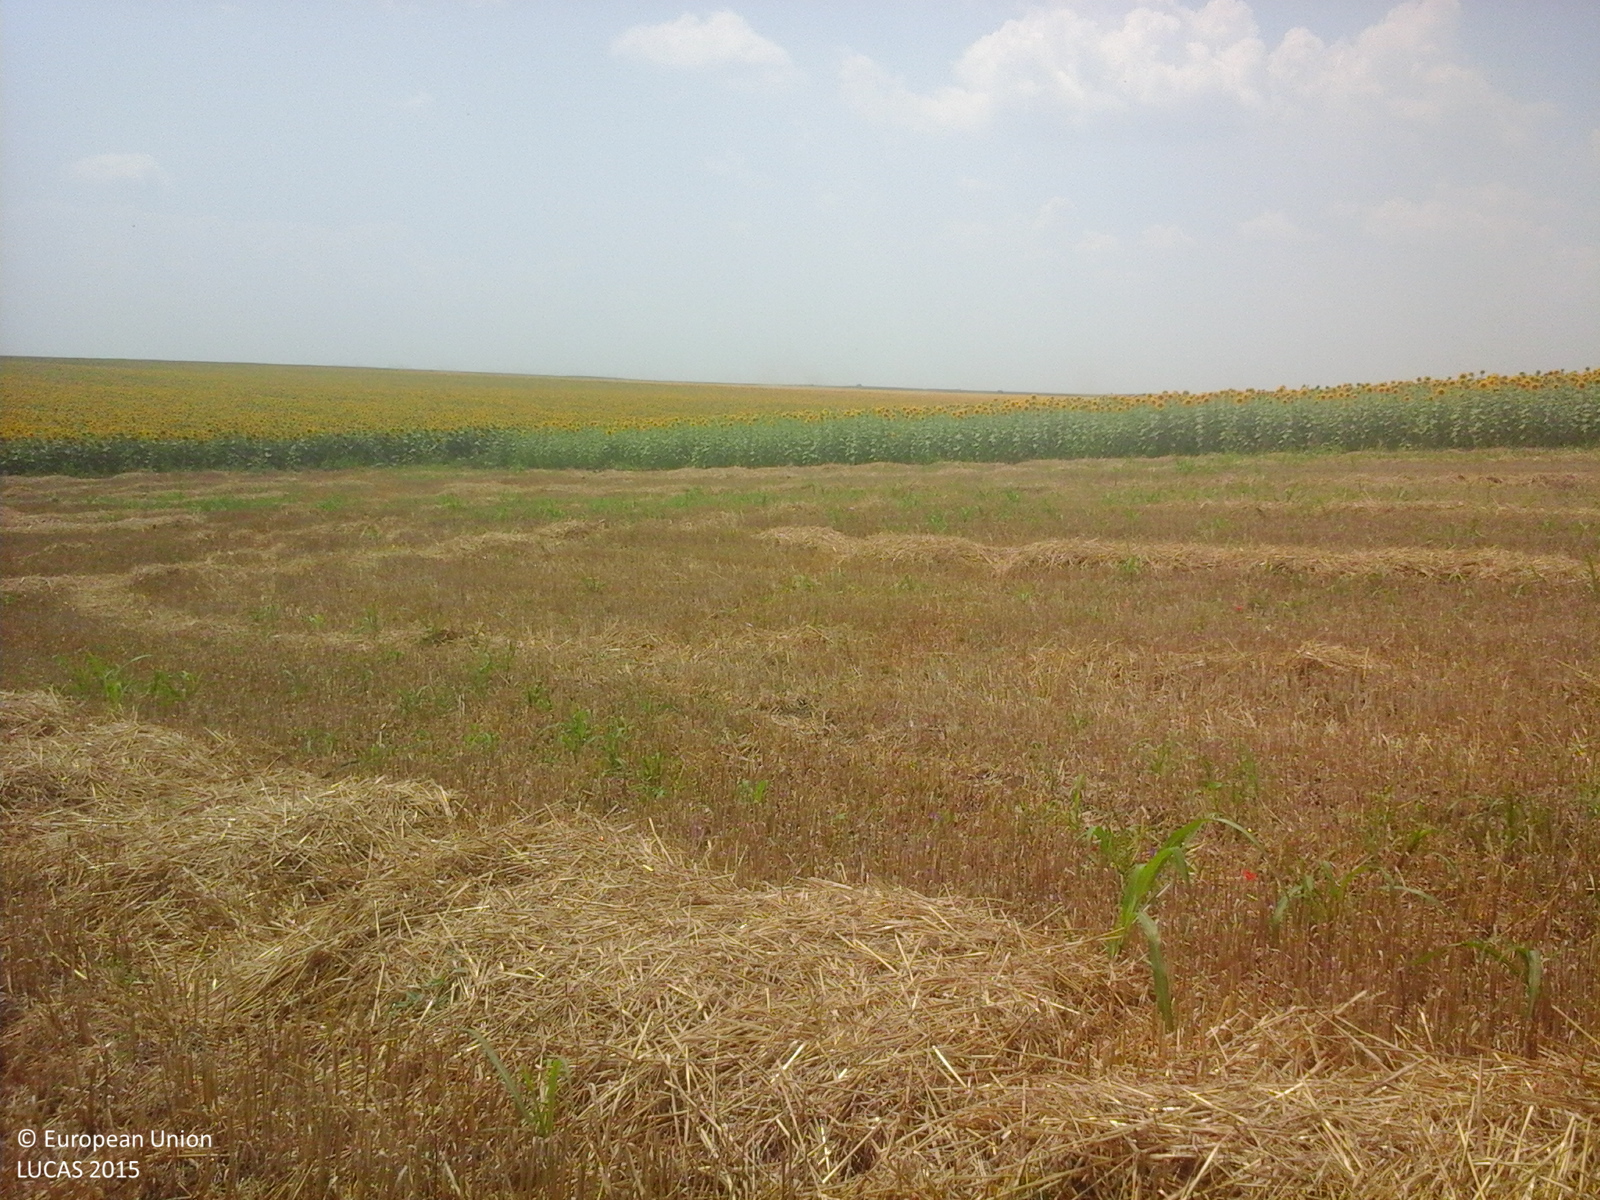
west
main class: Cropland
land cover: Barley
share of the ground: < 10 %
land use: Agriculture (excluding fallow land and kitchen gardens)
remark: Harvested field
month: July
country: RO
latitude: 43.7841
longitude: 25.1244
